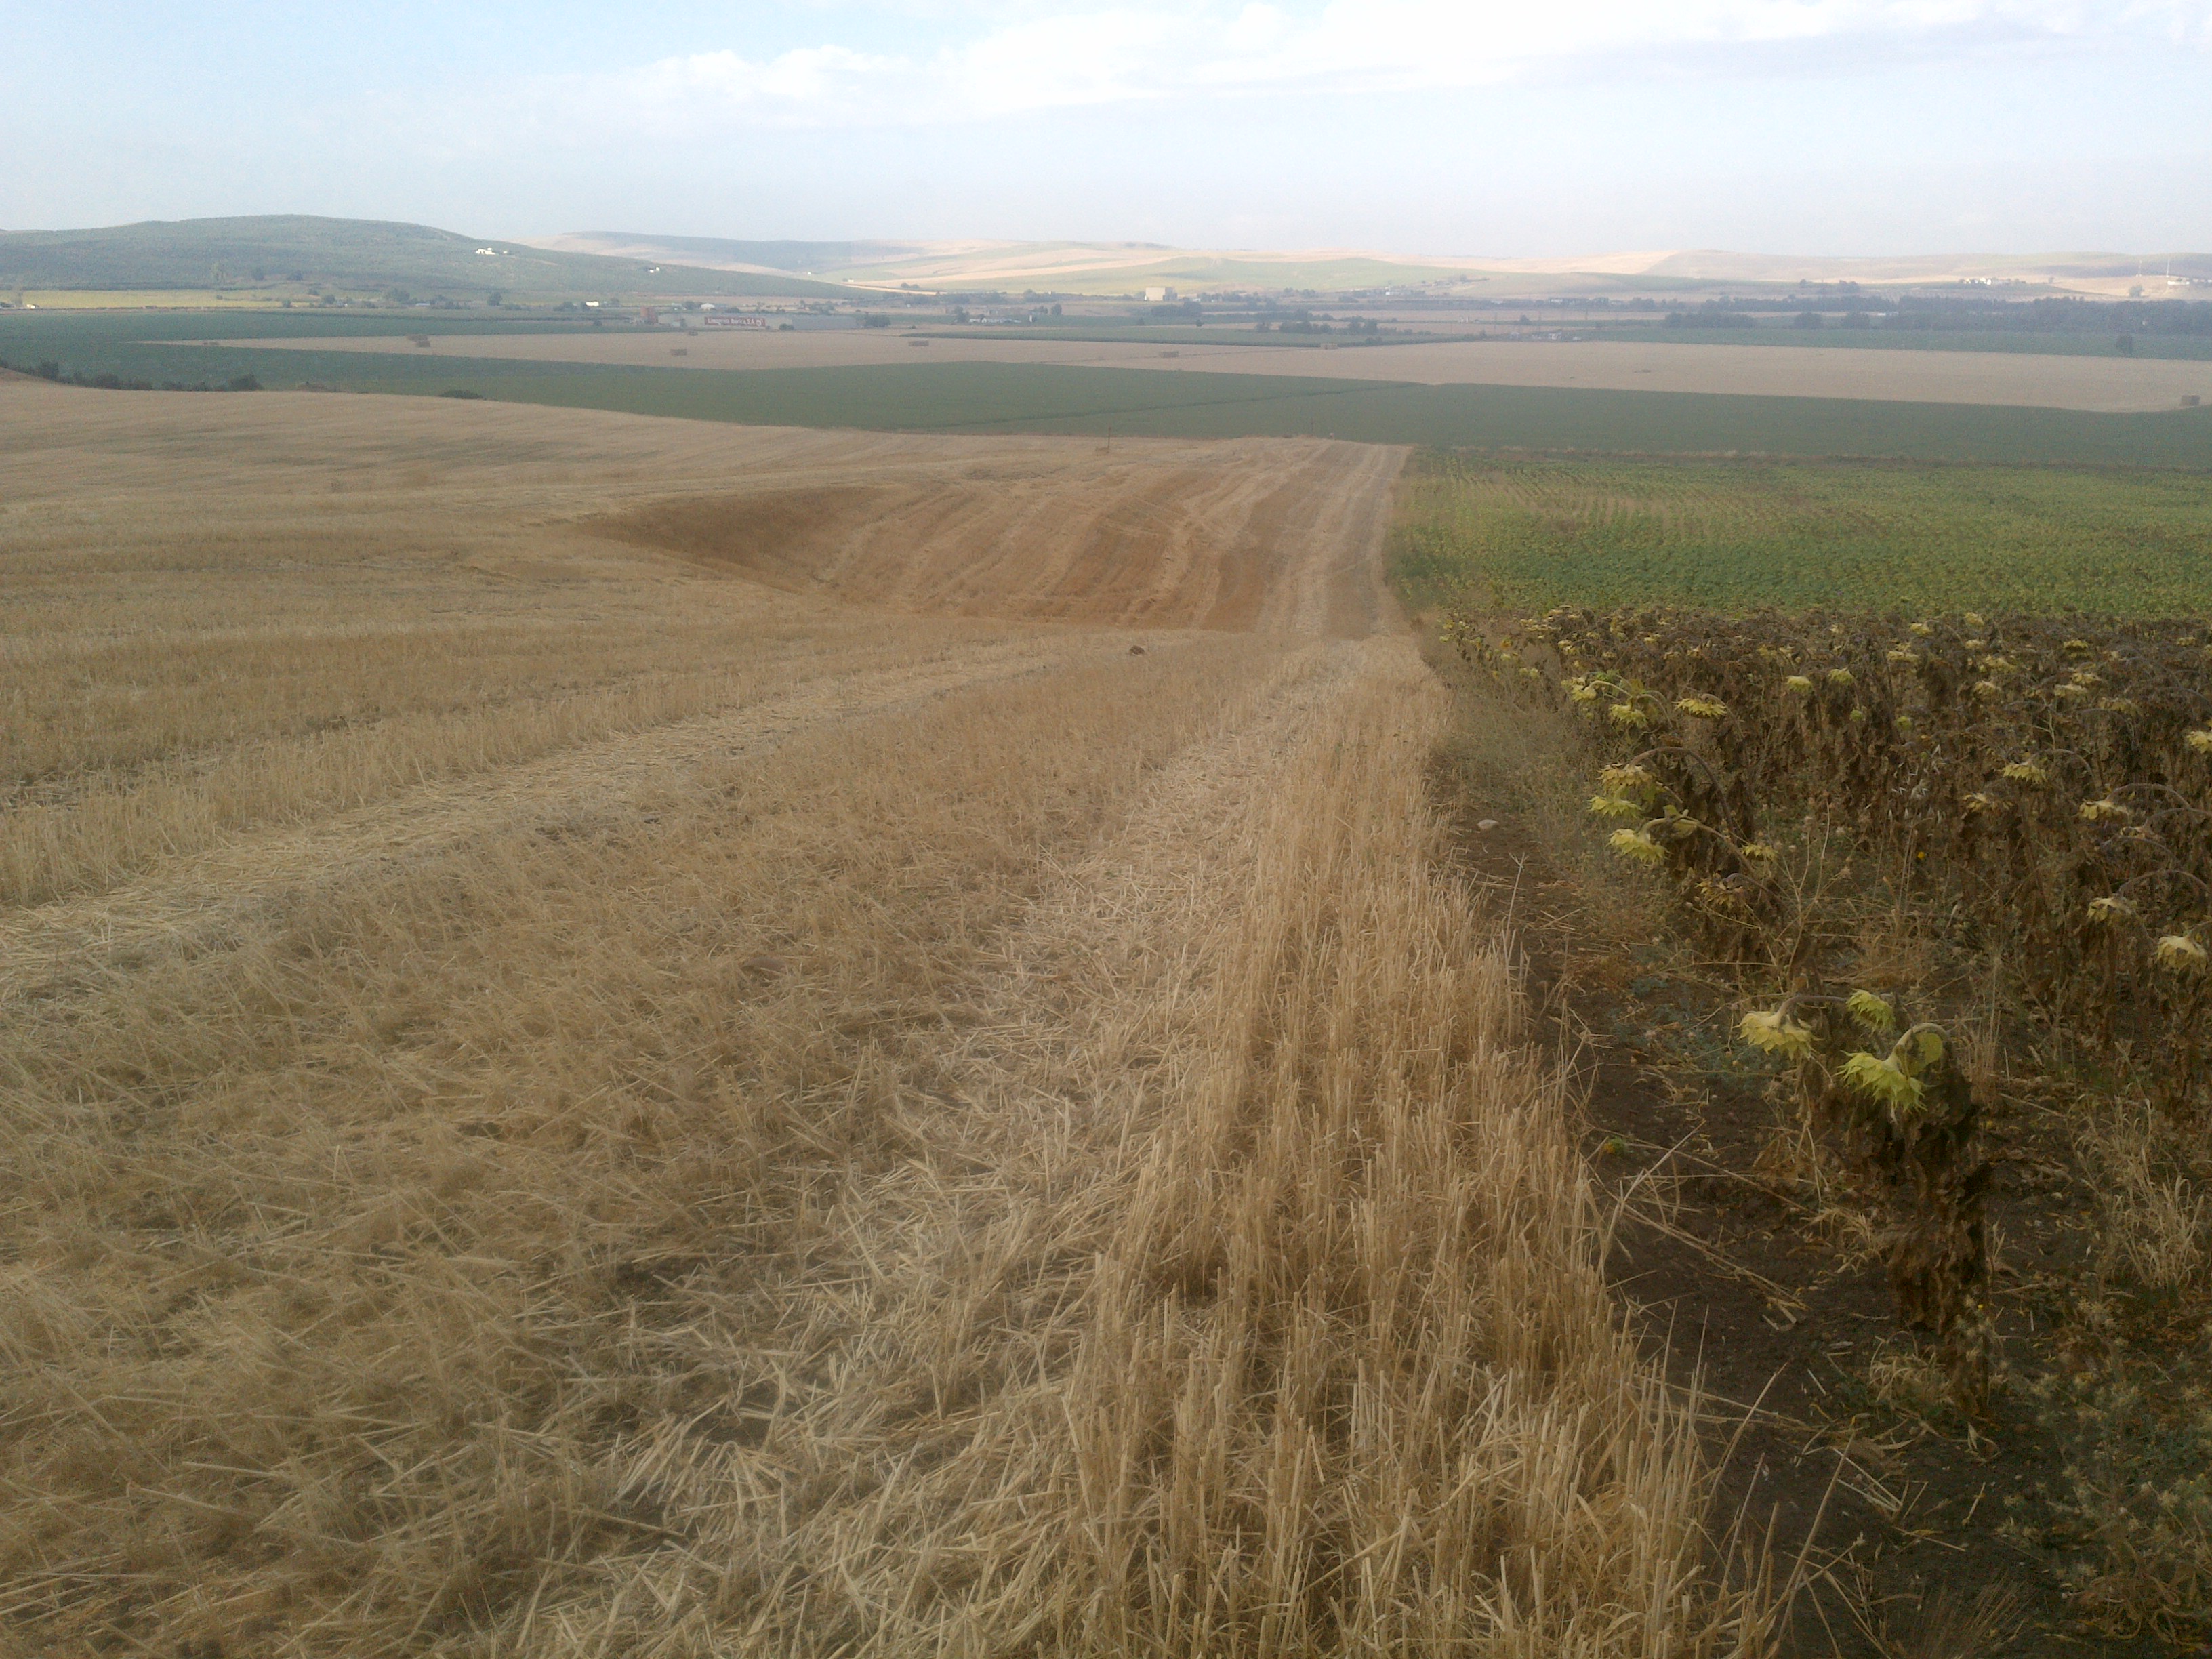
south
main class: Cropland
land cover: Sunflower
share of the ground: > 75 %
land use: Agriculture (excluding fallow land and kitchen gardens)
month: June
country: ES
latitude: 37.9398
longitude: -4.5888
